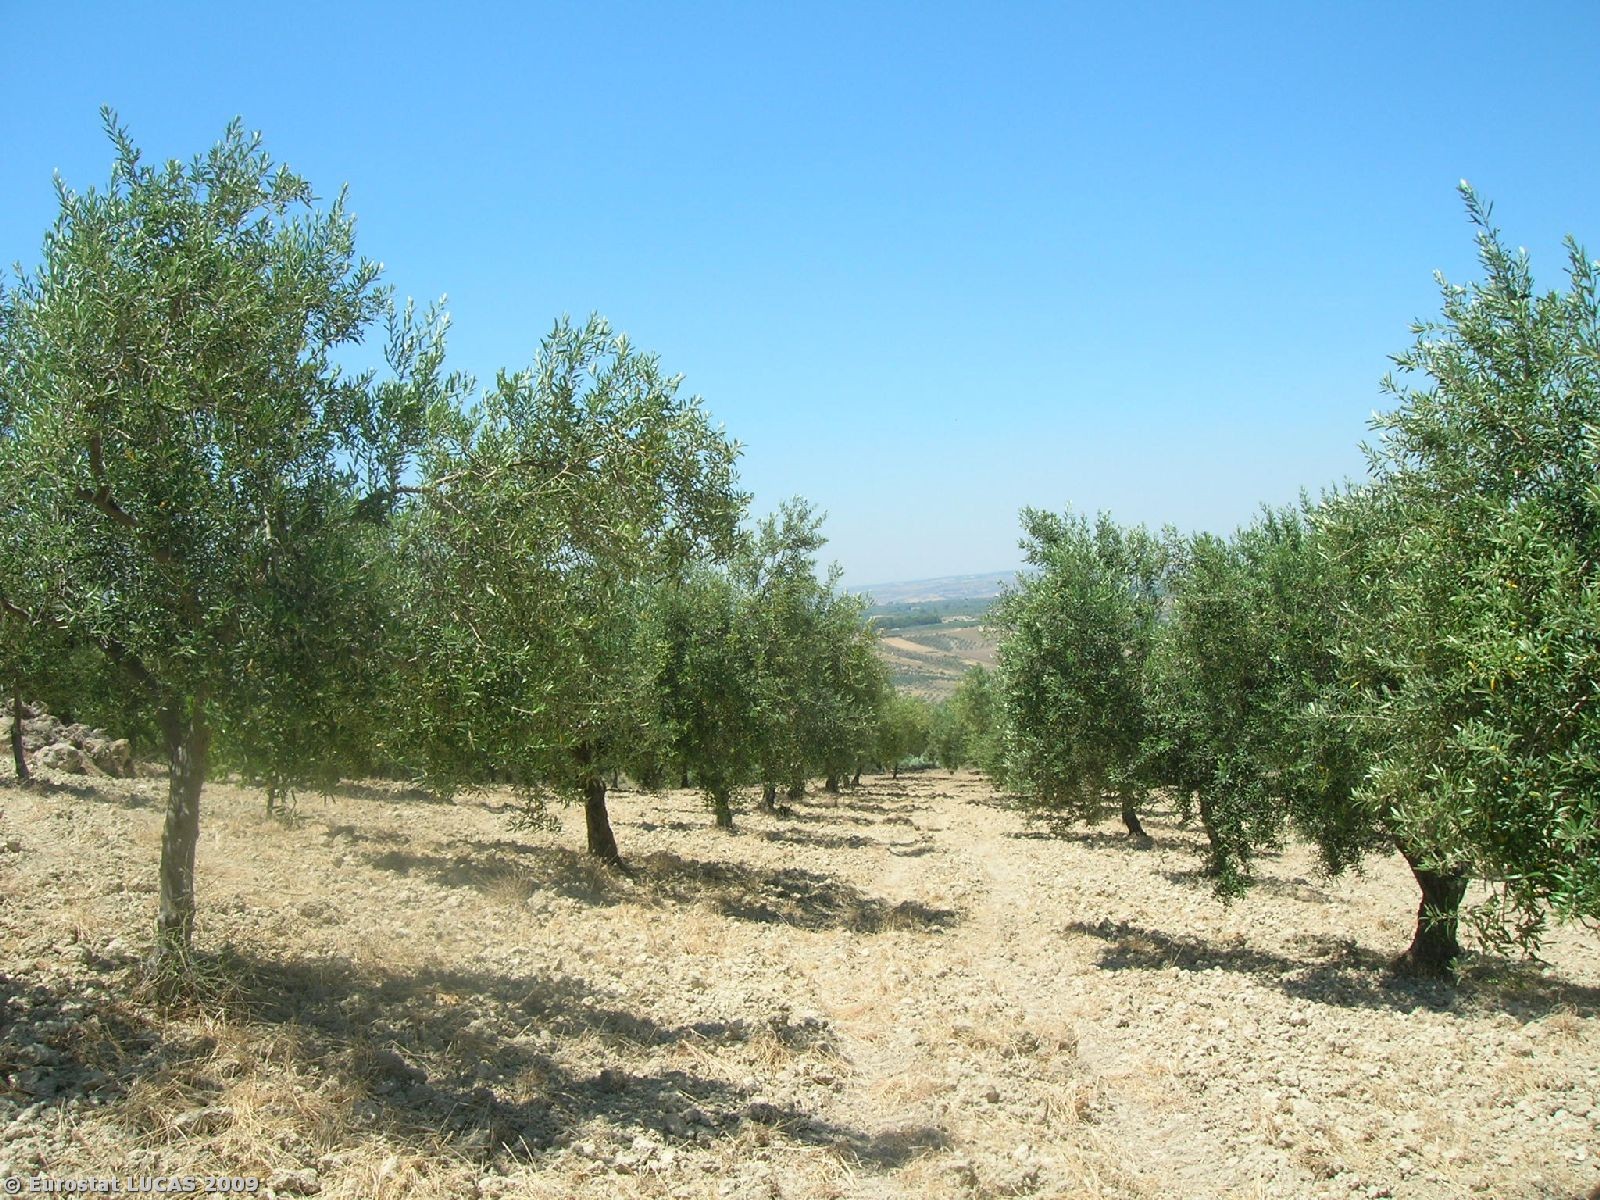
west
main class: Cropland
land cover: Olive groves
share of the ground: 50 - 75 %
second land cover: Bare land
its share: > 75 %
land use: Agriculture (excluding fallow land and kitchen gardens)
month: June
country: IT
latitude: 37.5332
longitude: 13.1109
